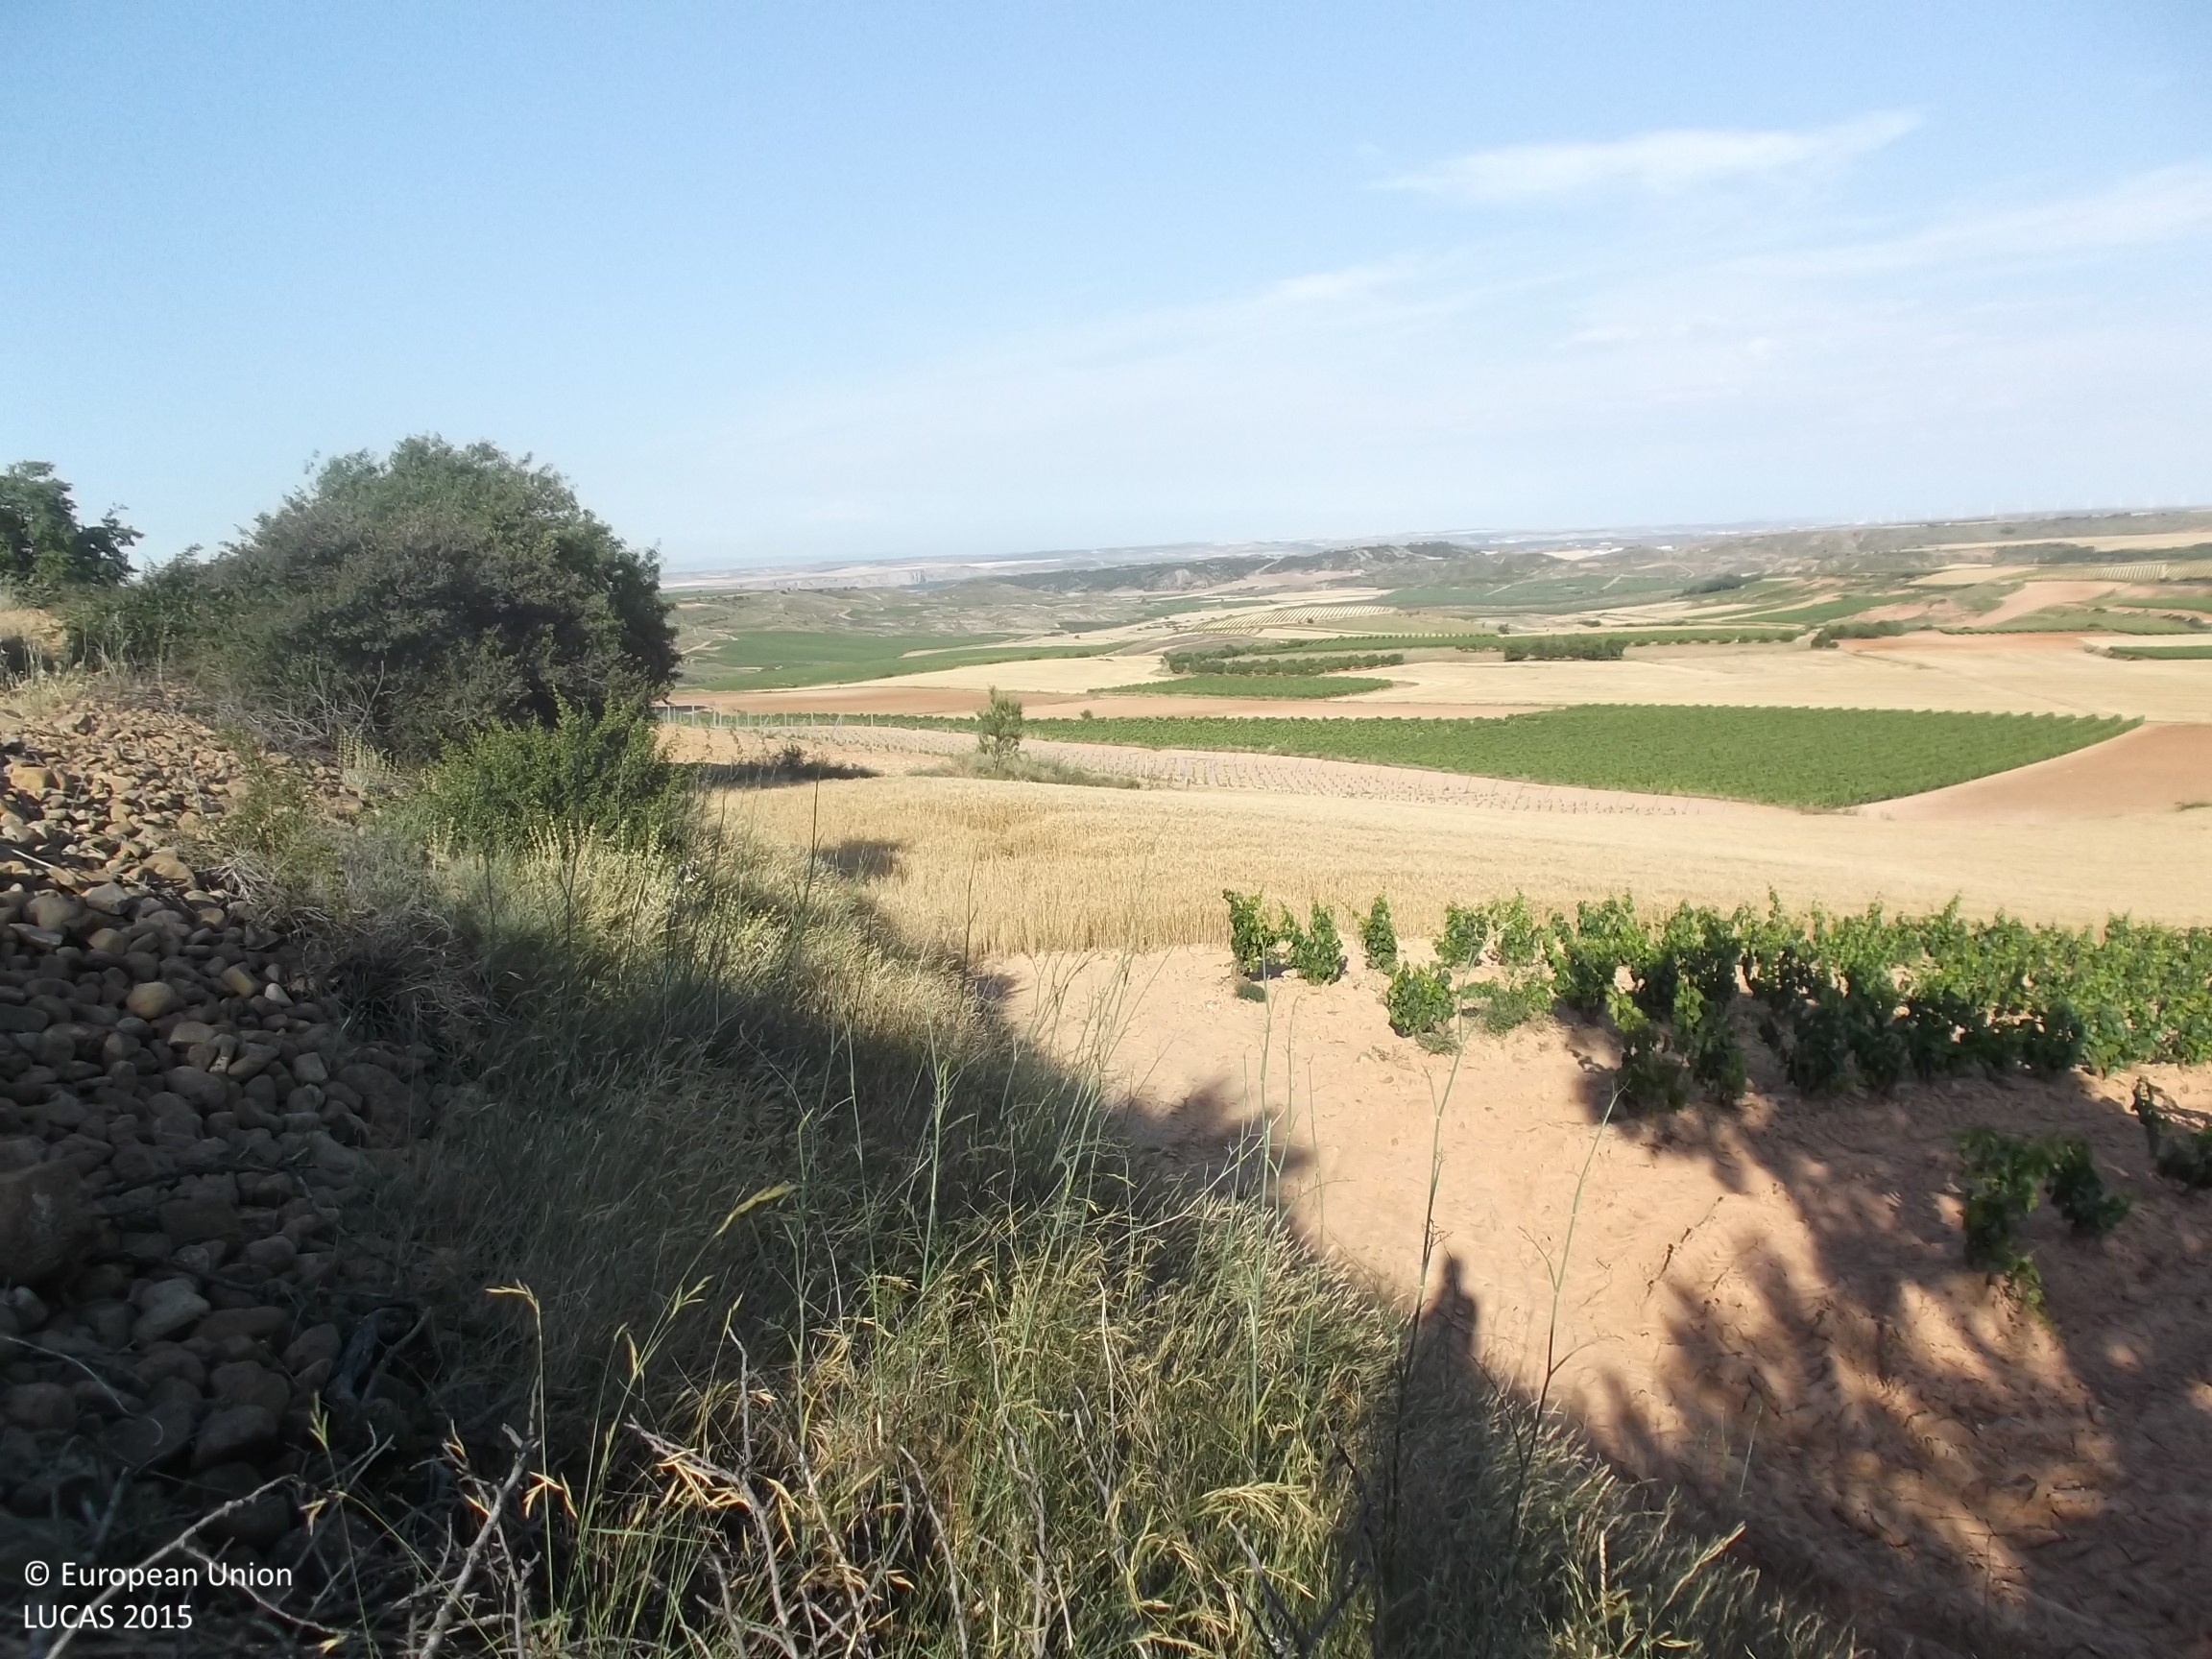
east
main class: Grassland
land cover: Grassland with sparse tree/shrub cover
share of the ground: 50 - 75 %
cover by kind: herbaceous plants 70 %, unconsolidated bare surface 25 %, broadleaved forest trees 5 %
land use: Semi-natural and natural areas not in use
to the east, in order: Grassland with sparse tree/shrub cover; Vineyards; Common wheat; Grass margins; Vineyards; Grassland without tree/shrub cover; Vineyards
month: June
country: ES
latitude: 42.3581
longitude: -2.1450
